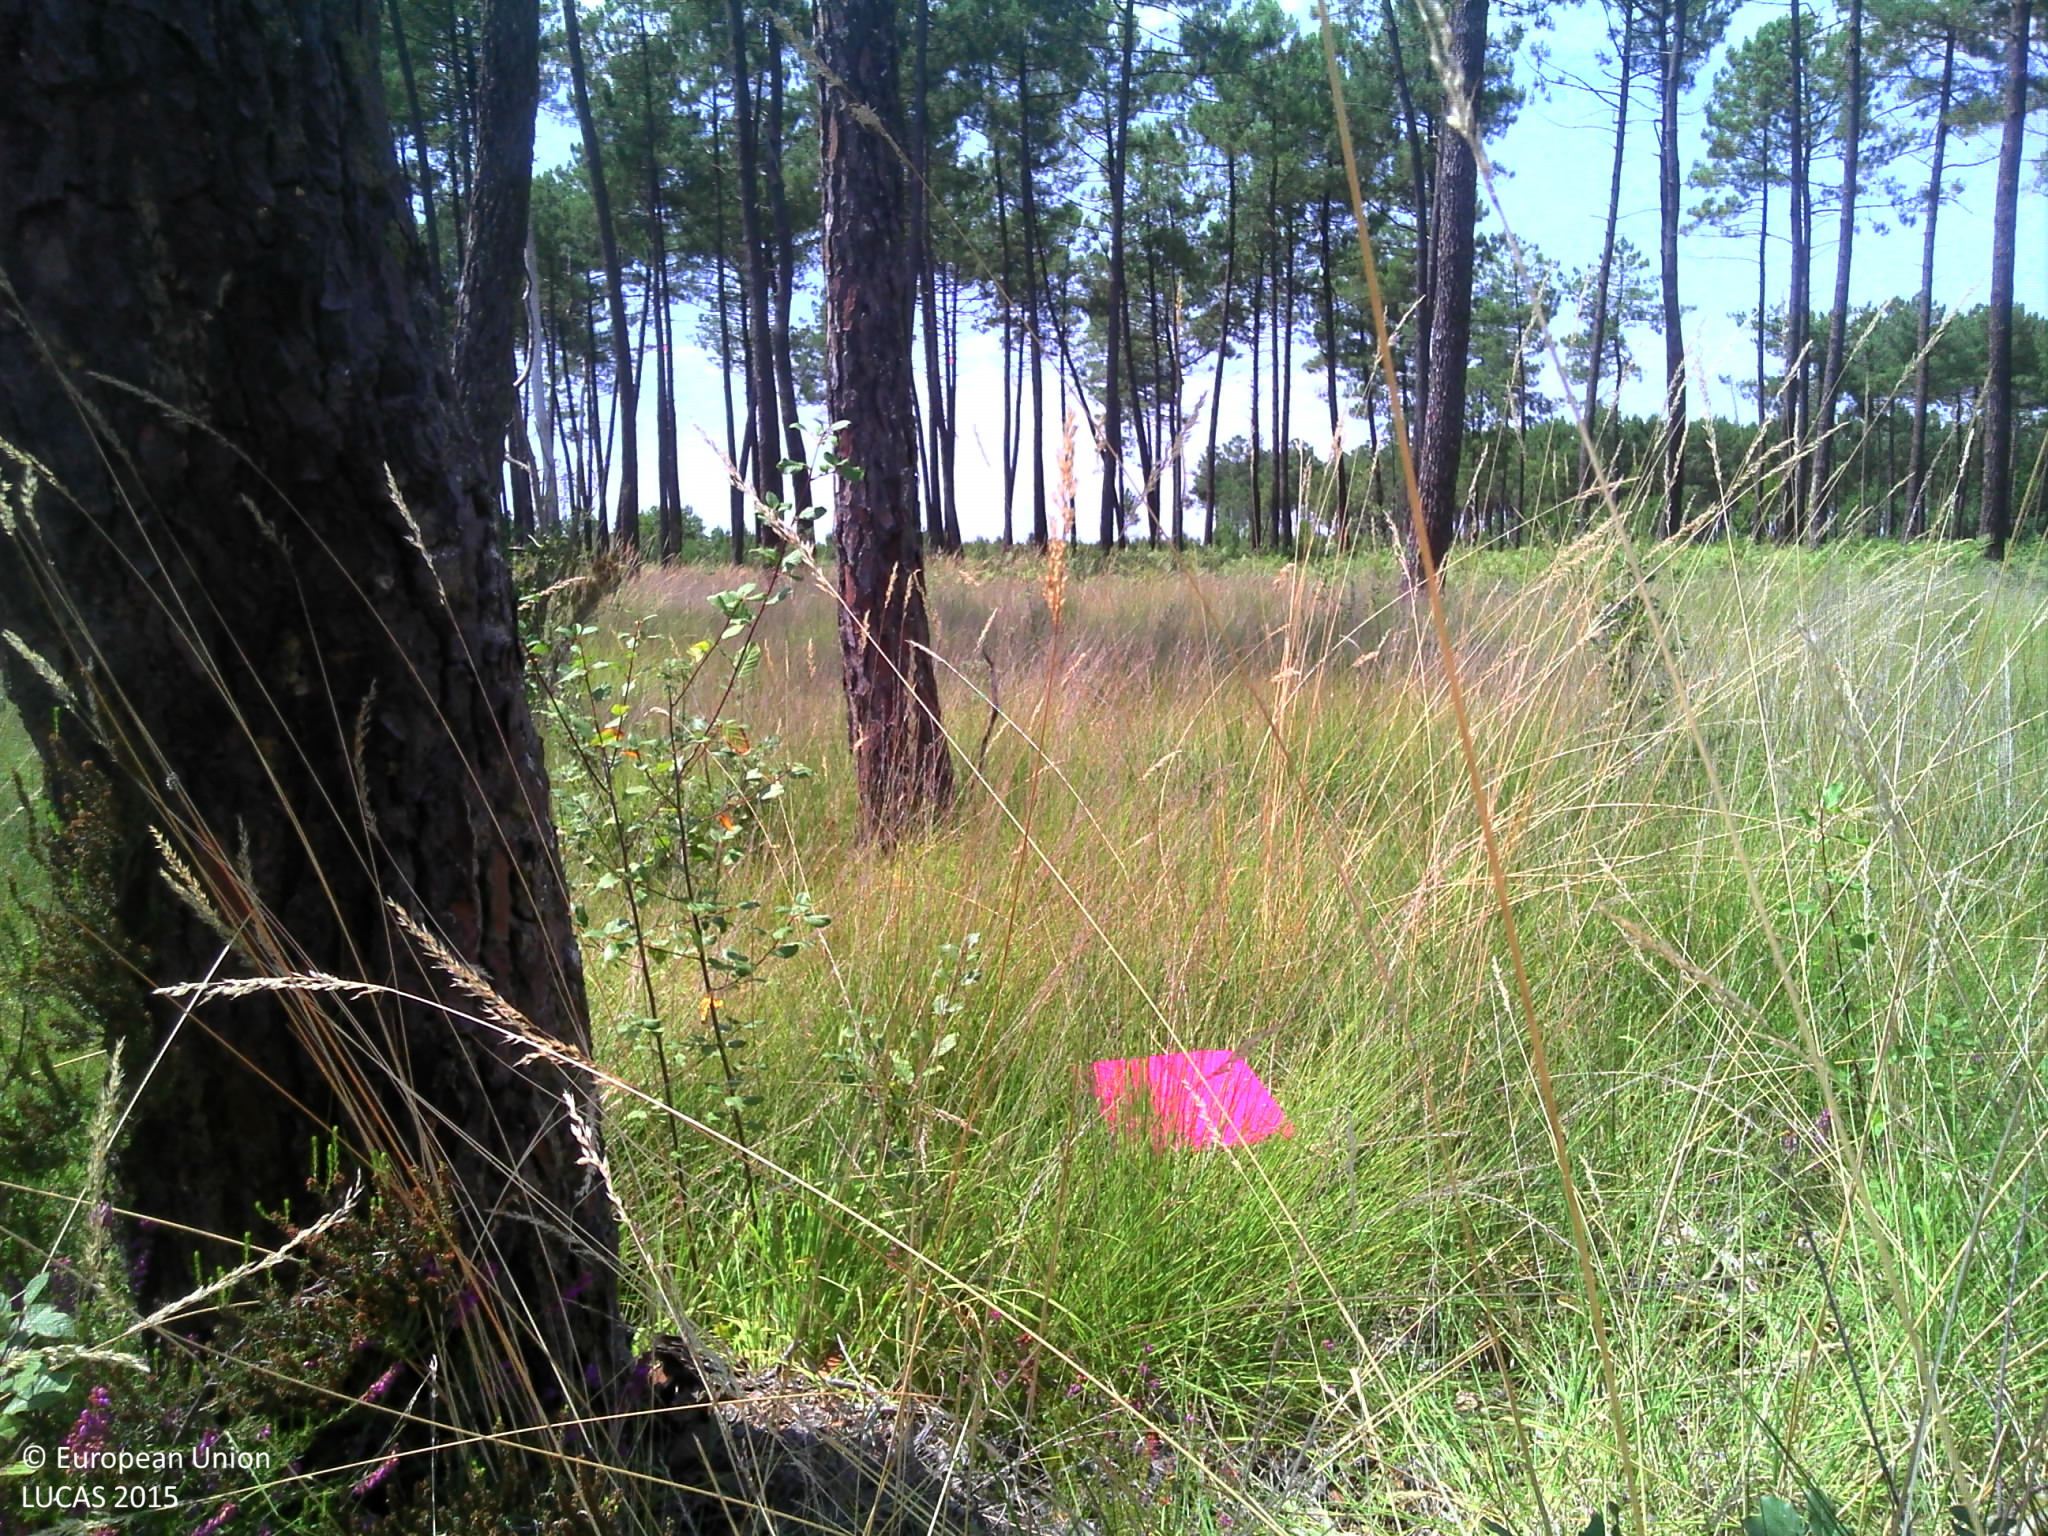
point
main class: Woodland
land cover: Pine dominated coniferous woodland
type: coniferous forest of the mediterranean region
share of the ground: > 75 %
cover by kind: coniferous forest trees 70 %, herbaceous plants 30 %
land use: Forestry
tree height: > 5 m
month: July
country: FR
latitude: 44.2300
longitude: -0.5432
